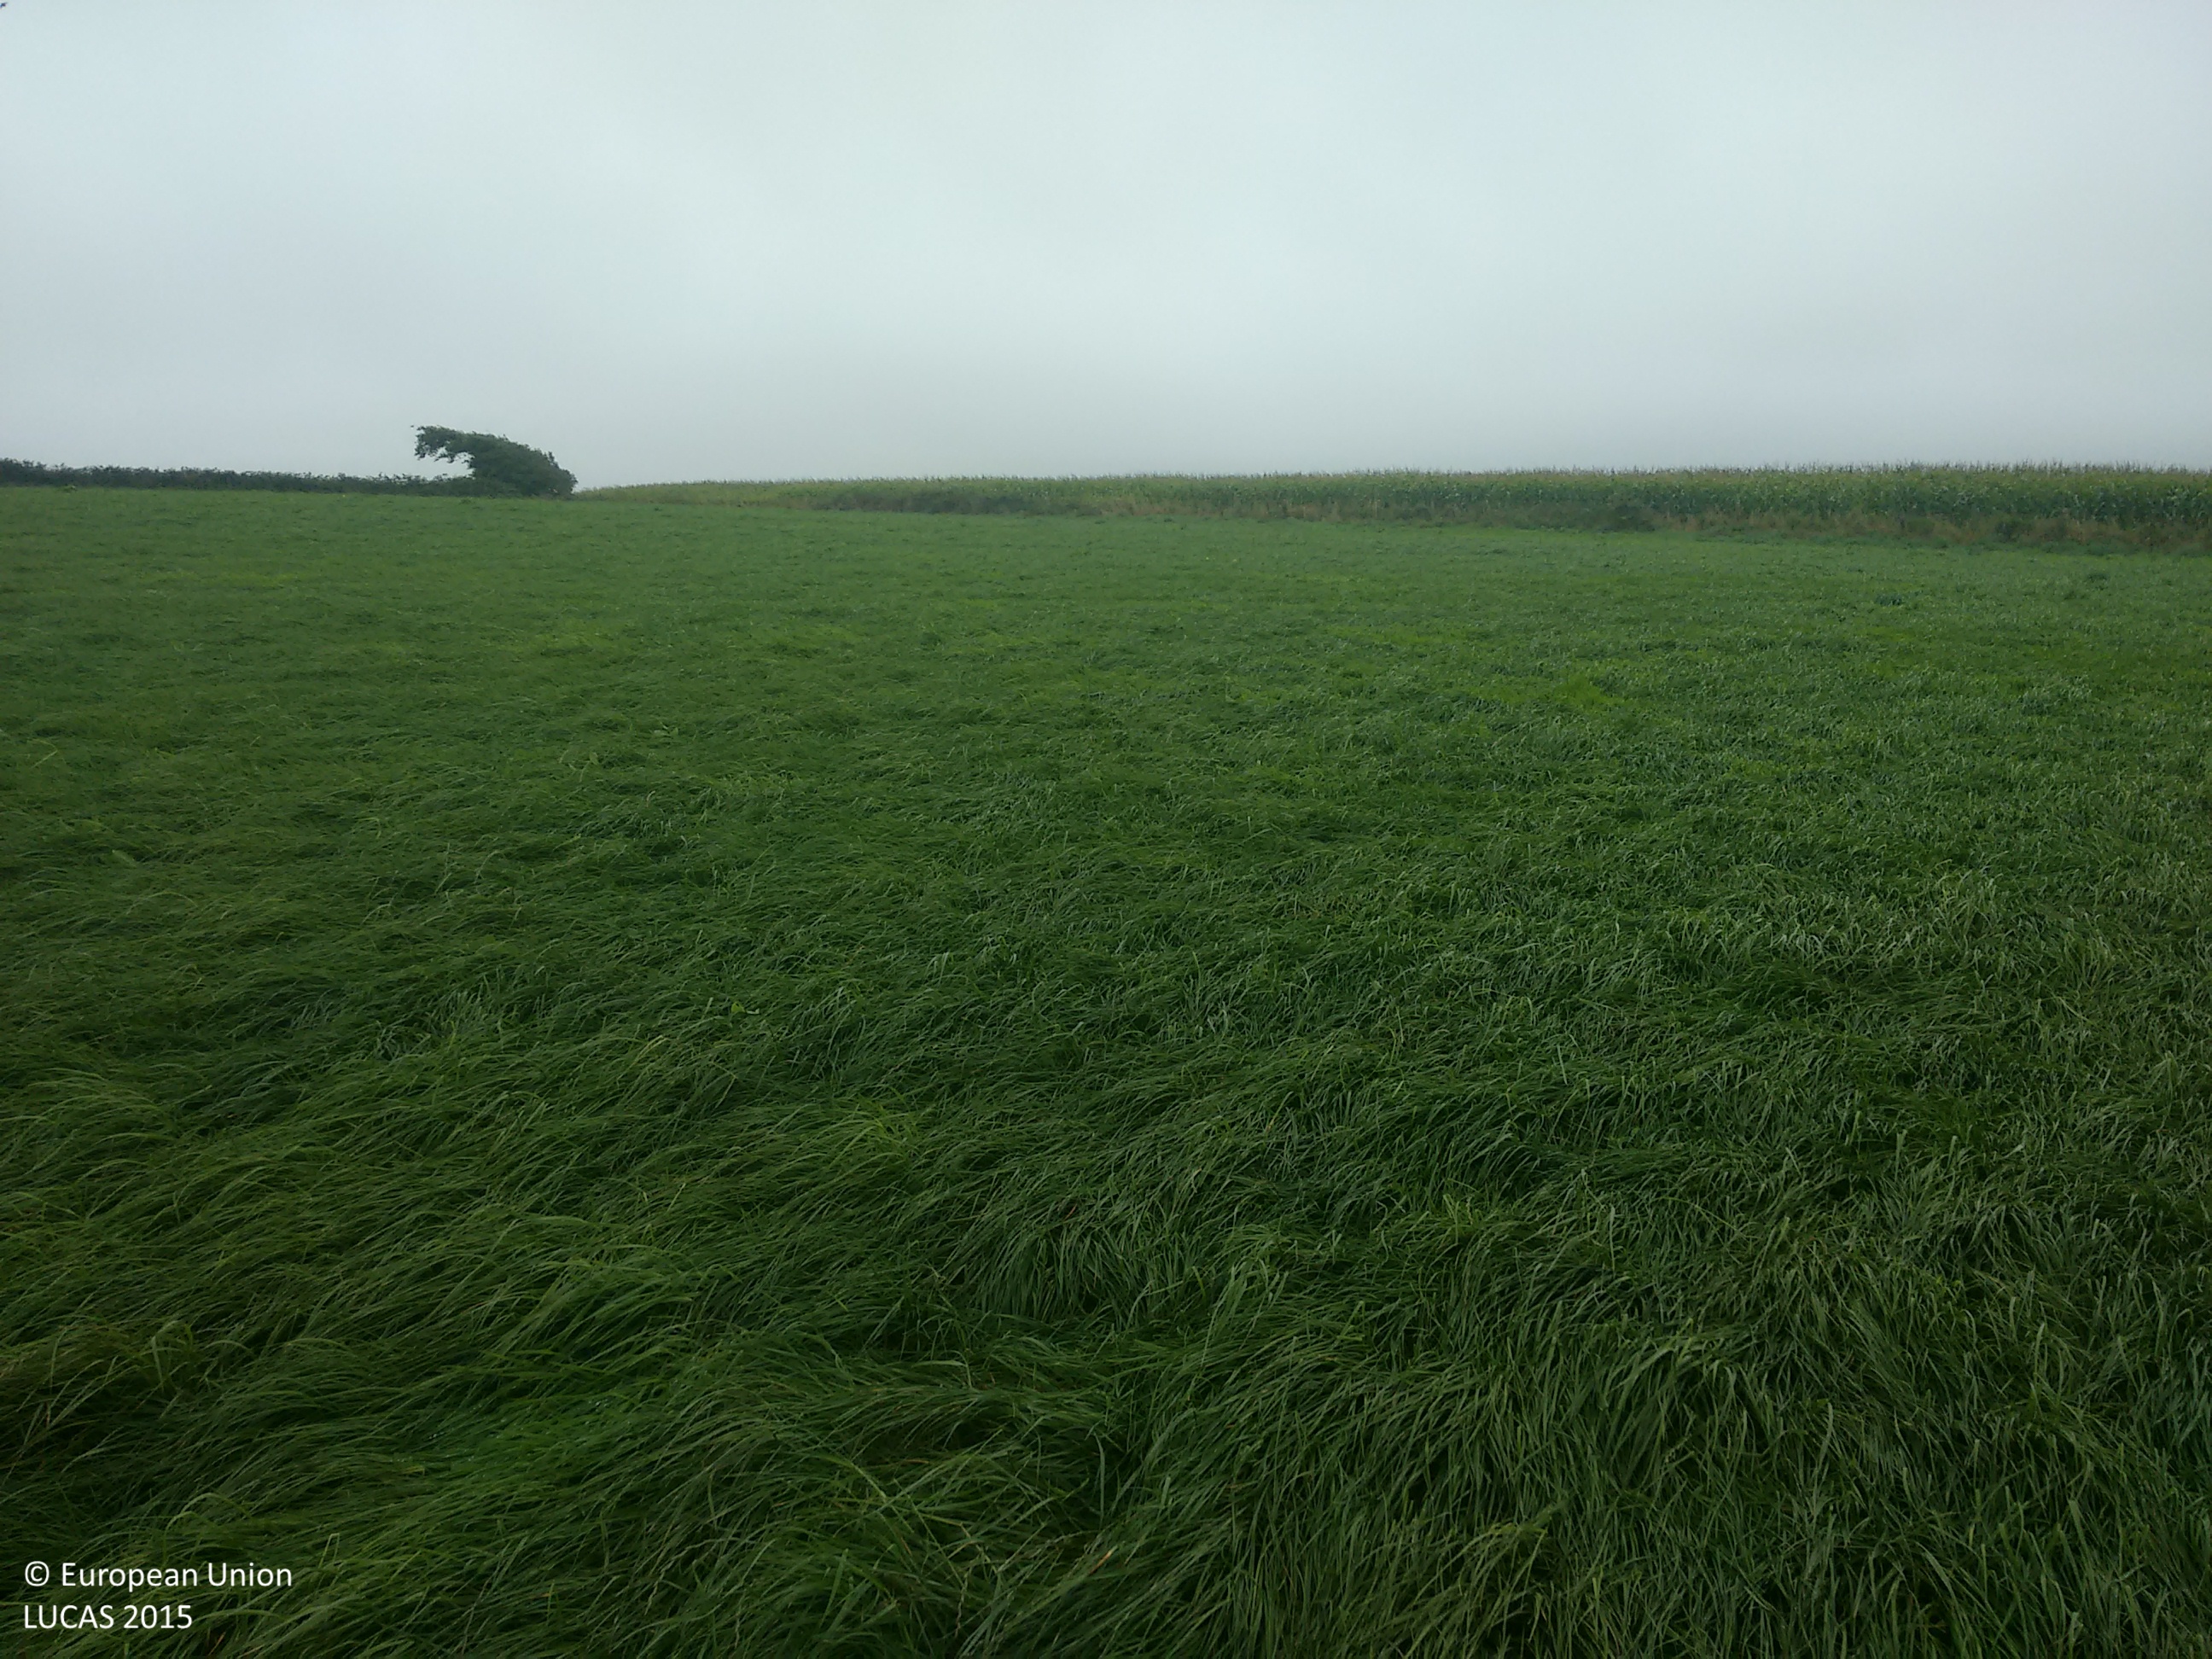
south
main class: Grassland
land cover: Grassland without tree/shrub cover
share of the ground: > 75 %
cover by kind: herbaceous plants 100 %
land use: Agriculture (excluding fallow land and kitchen gardens)
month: August
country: GB
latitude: 50.0665
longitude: -5.1080
